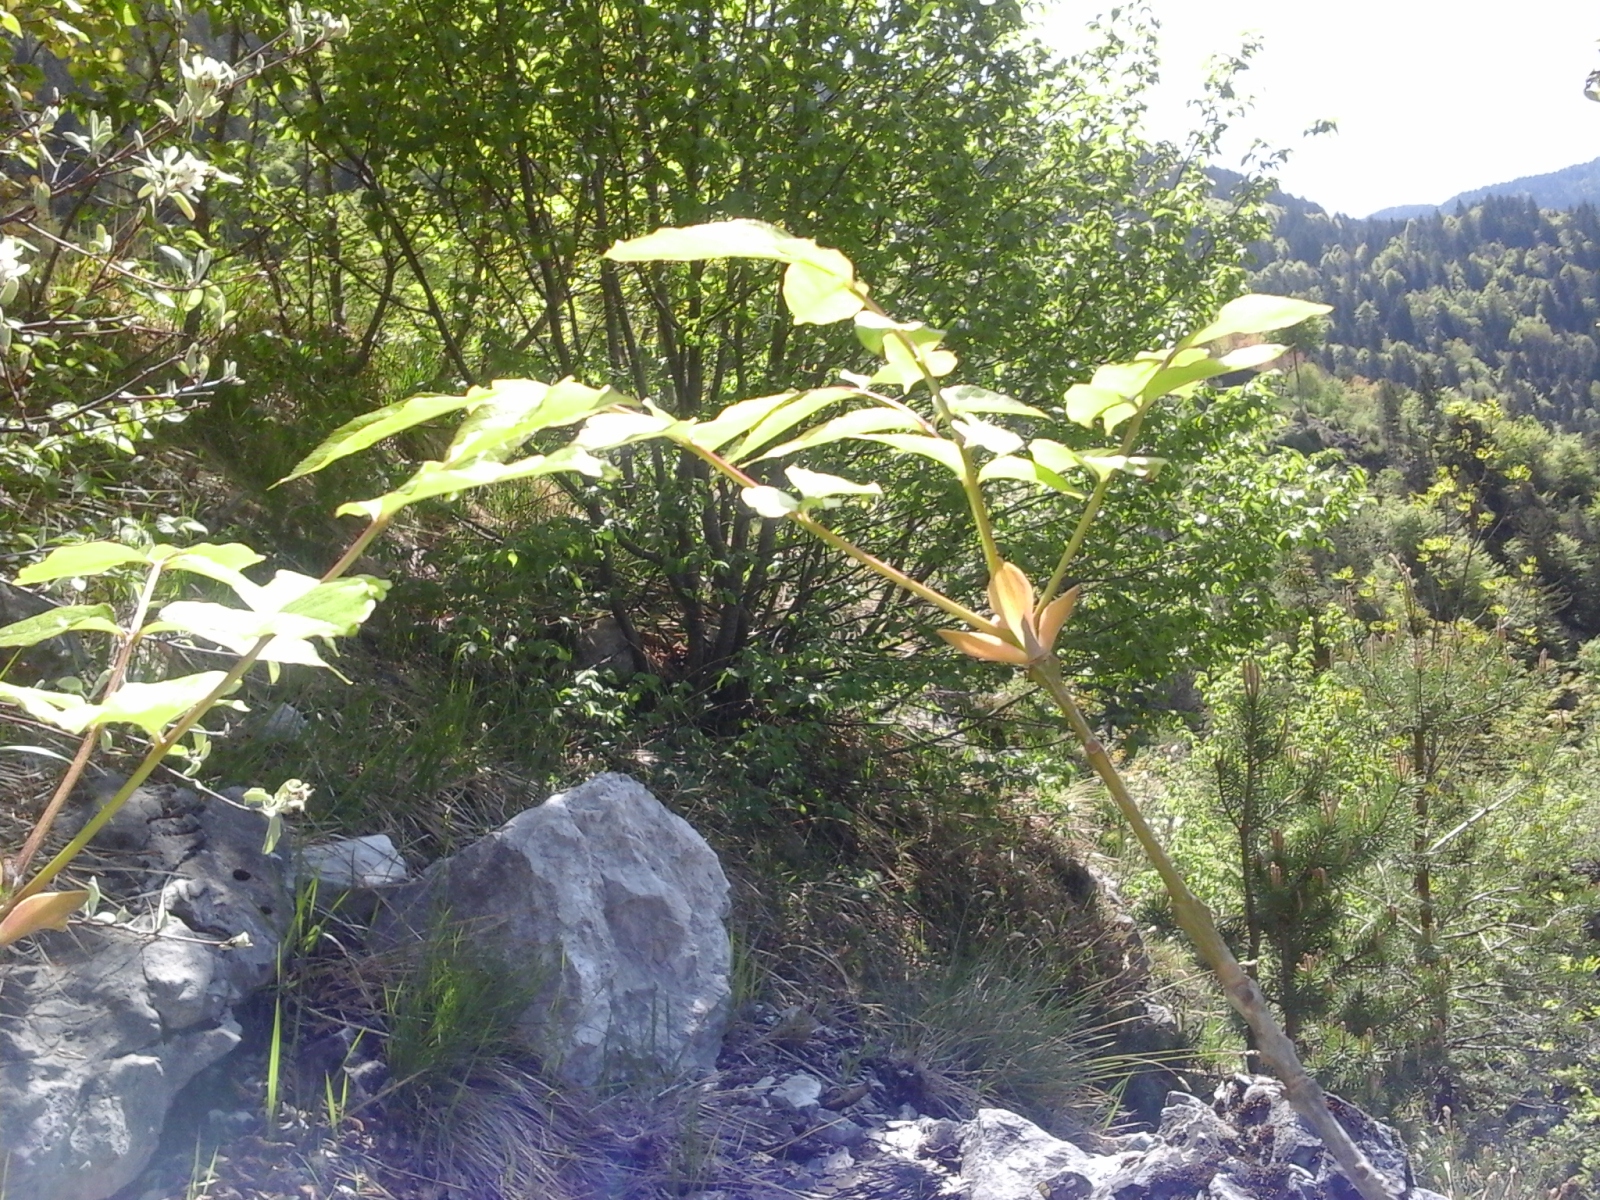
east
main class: Woodland
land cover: Other mixed woodland
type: alpine coniferous forest
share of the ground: > 75 %
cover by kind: shrubs 50 %, herbaceous plants 15 %, unconsolidated bare surface 15 %, coniferous forest trees 10 %, broadleaved forest trees 10 %
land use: Forestry
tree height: > 5 m
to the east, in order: Other mixed woodland; Rock outcrops; Other mixed woodland; Electric lines; Other mixed woodland; Tracks; Other mixed woodland; Paved roads, cycling and walking lanes; Other mixed woodland
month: May
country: IT
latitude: 45.8628
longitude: 10.6559
